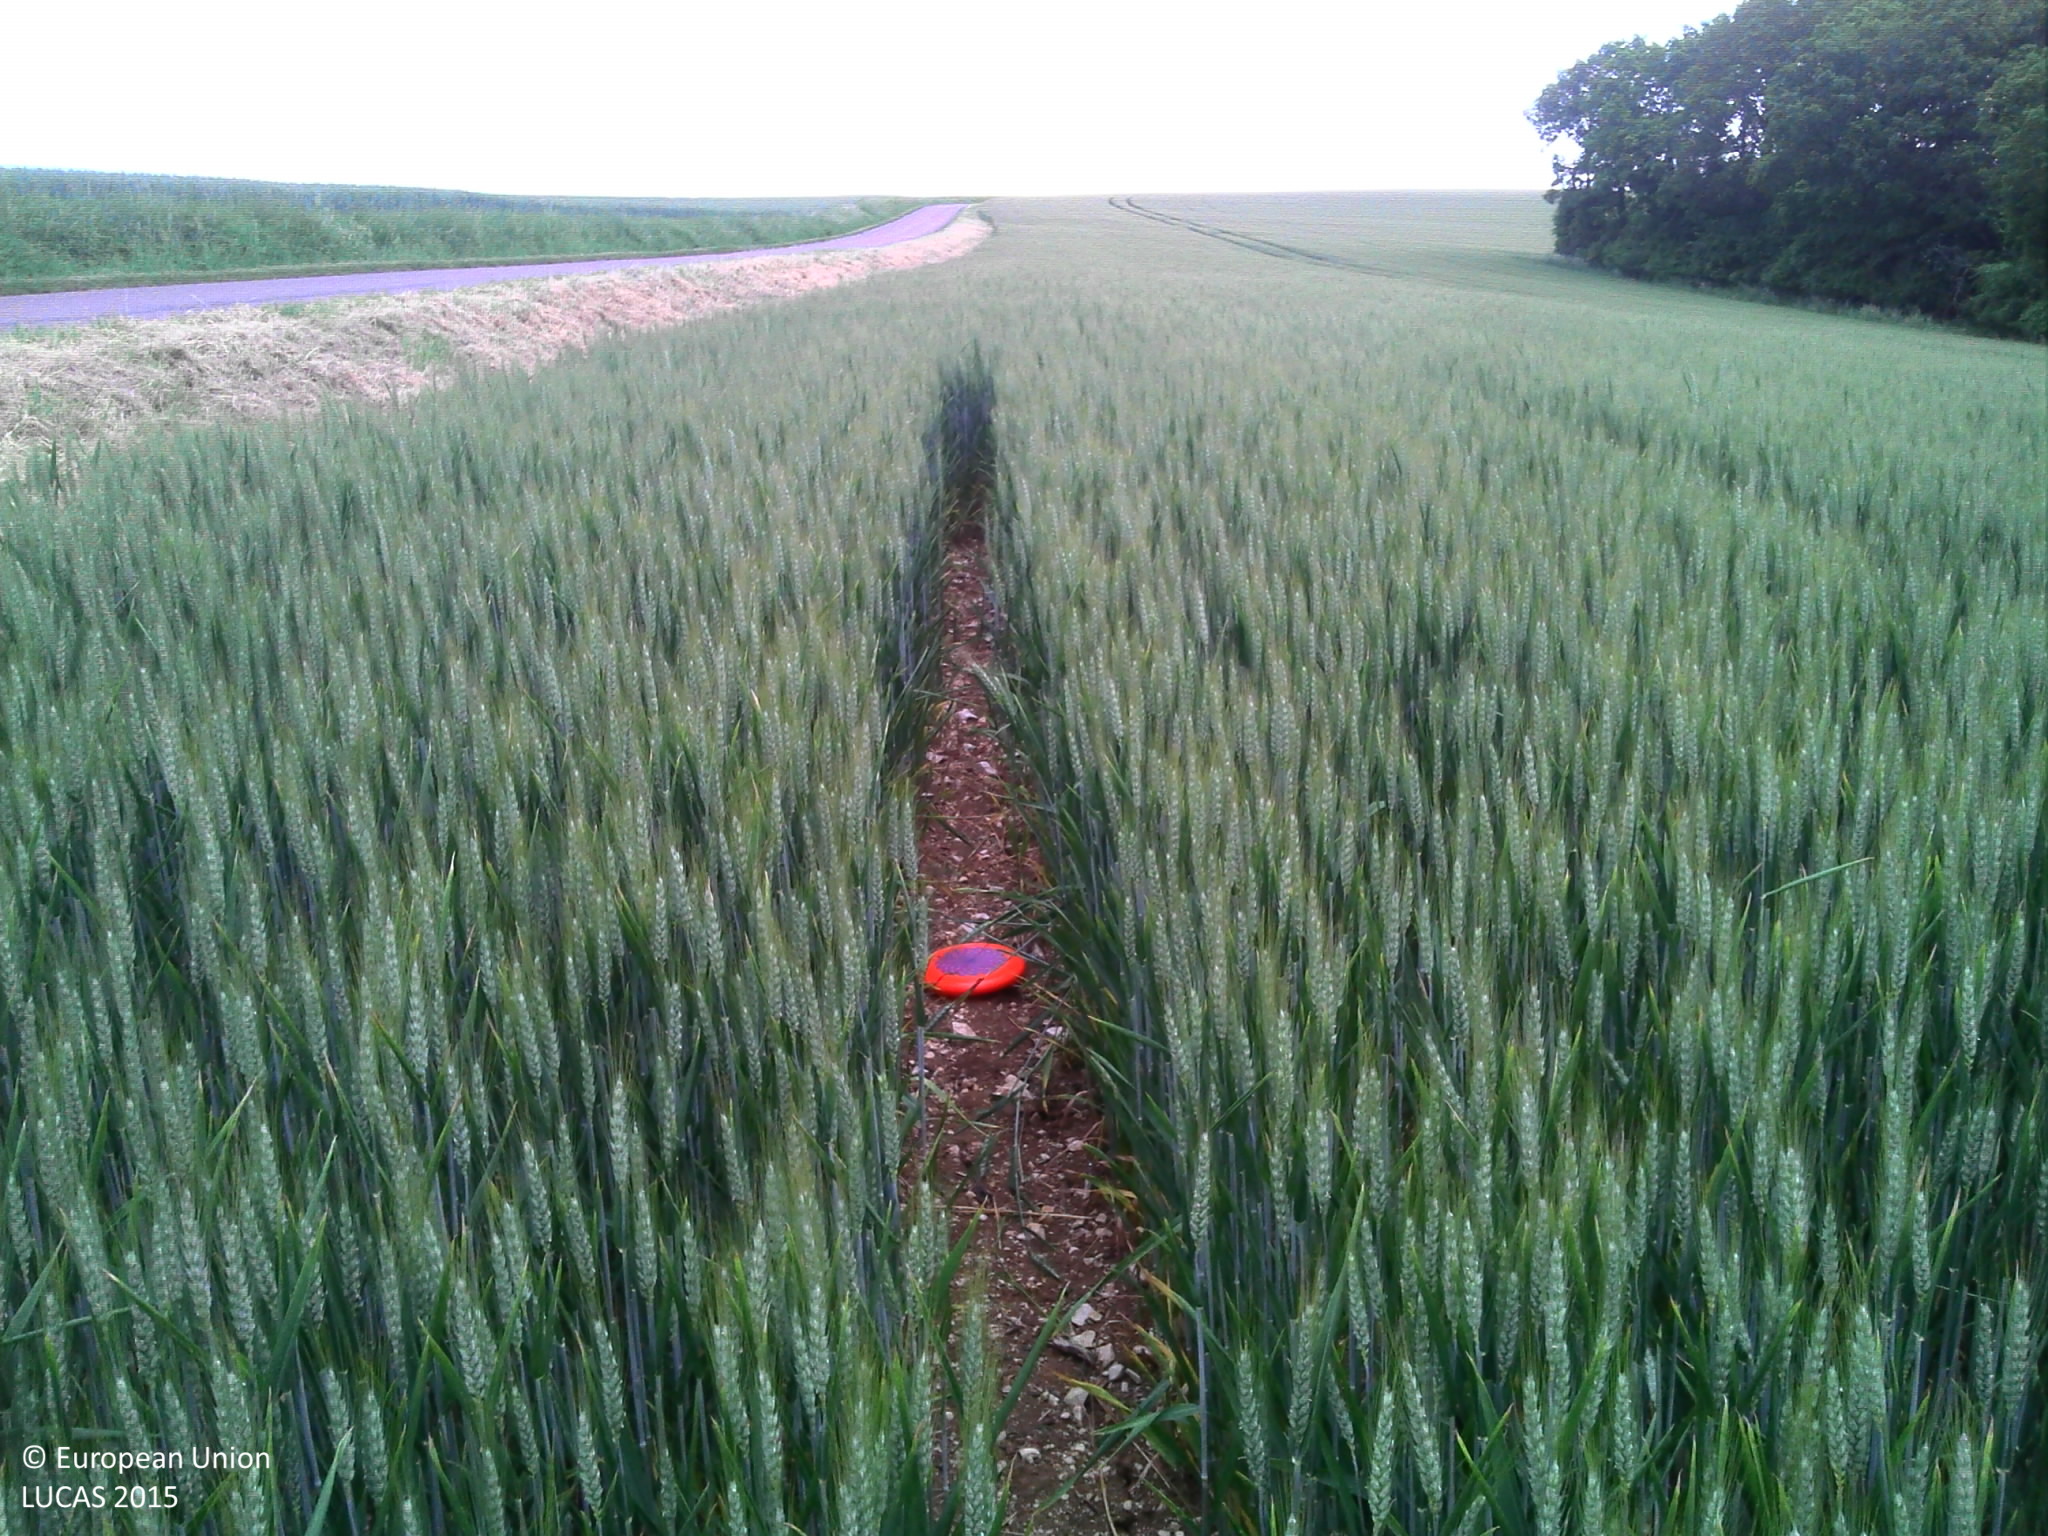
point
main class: Cropland
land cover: Common wheat
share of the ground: > 75 %
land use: Agriculture (excluding fallow land and kitchen gardens)
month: May
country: FR
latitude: 47.7852
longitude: 3.9238
